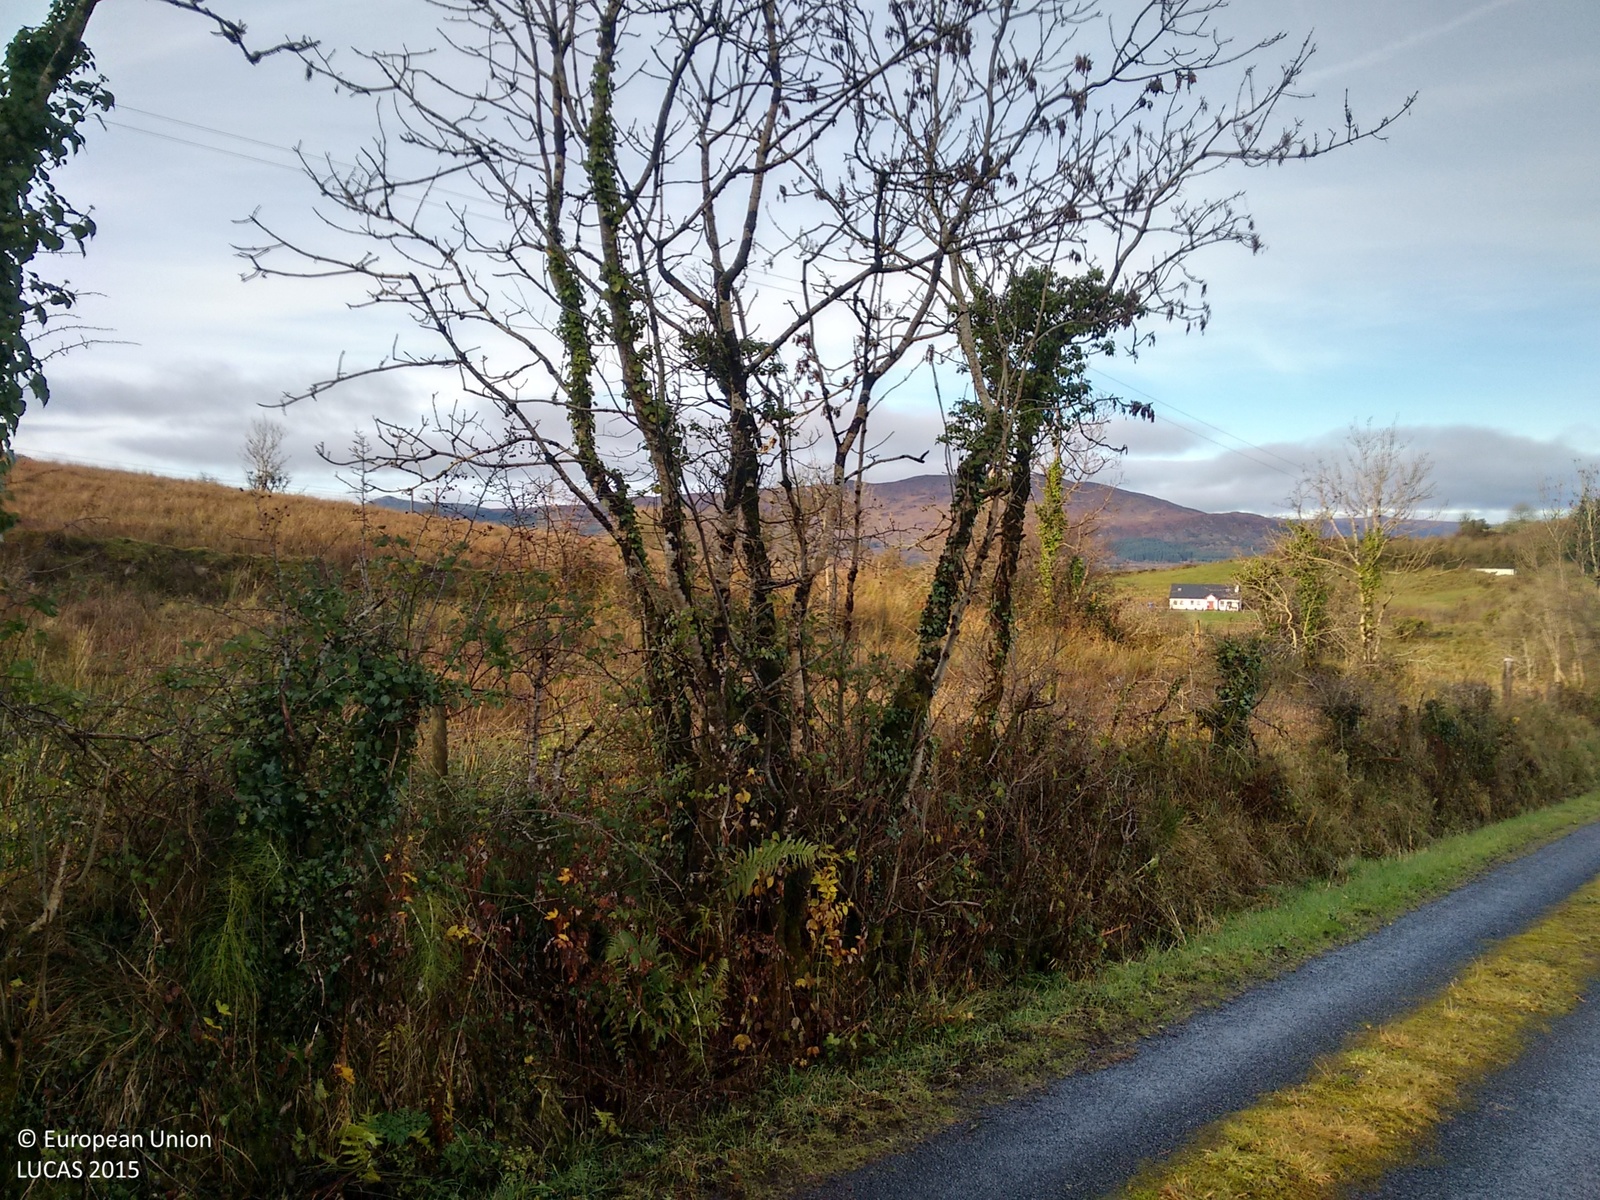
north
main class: Woodland
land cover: Broadleaved woodland
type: exotic forest
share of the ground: > 75 %
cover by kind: broadleaved forest trees 95 %, coniferous forest trees 5 %
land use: Forestry
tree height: > 5 m
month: November
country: IE
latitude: 54.2386
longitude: -8.2098
